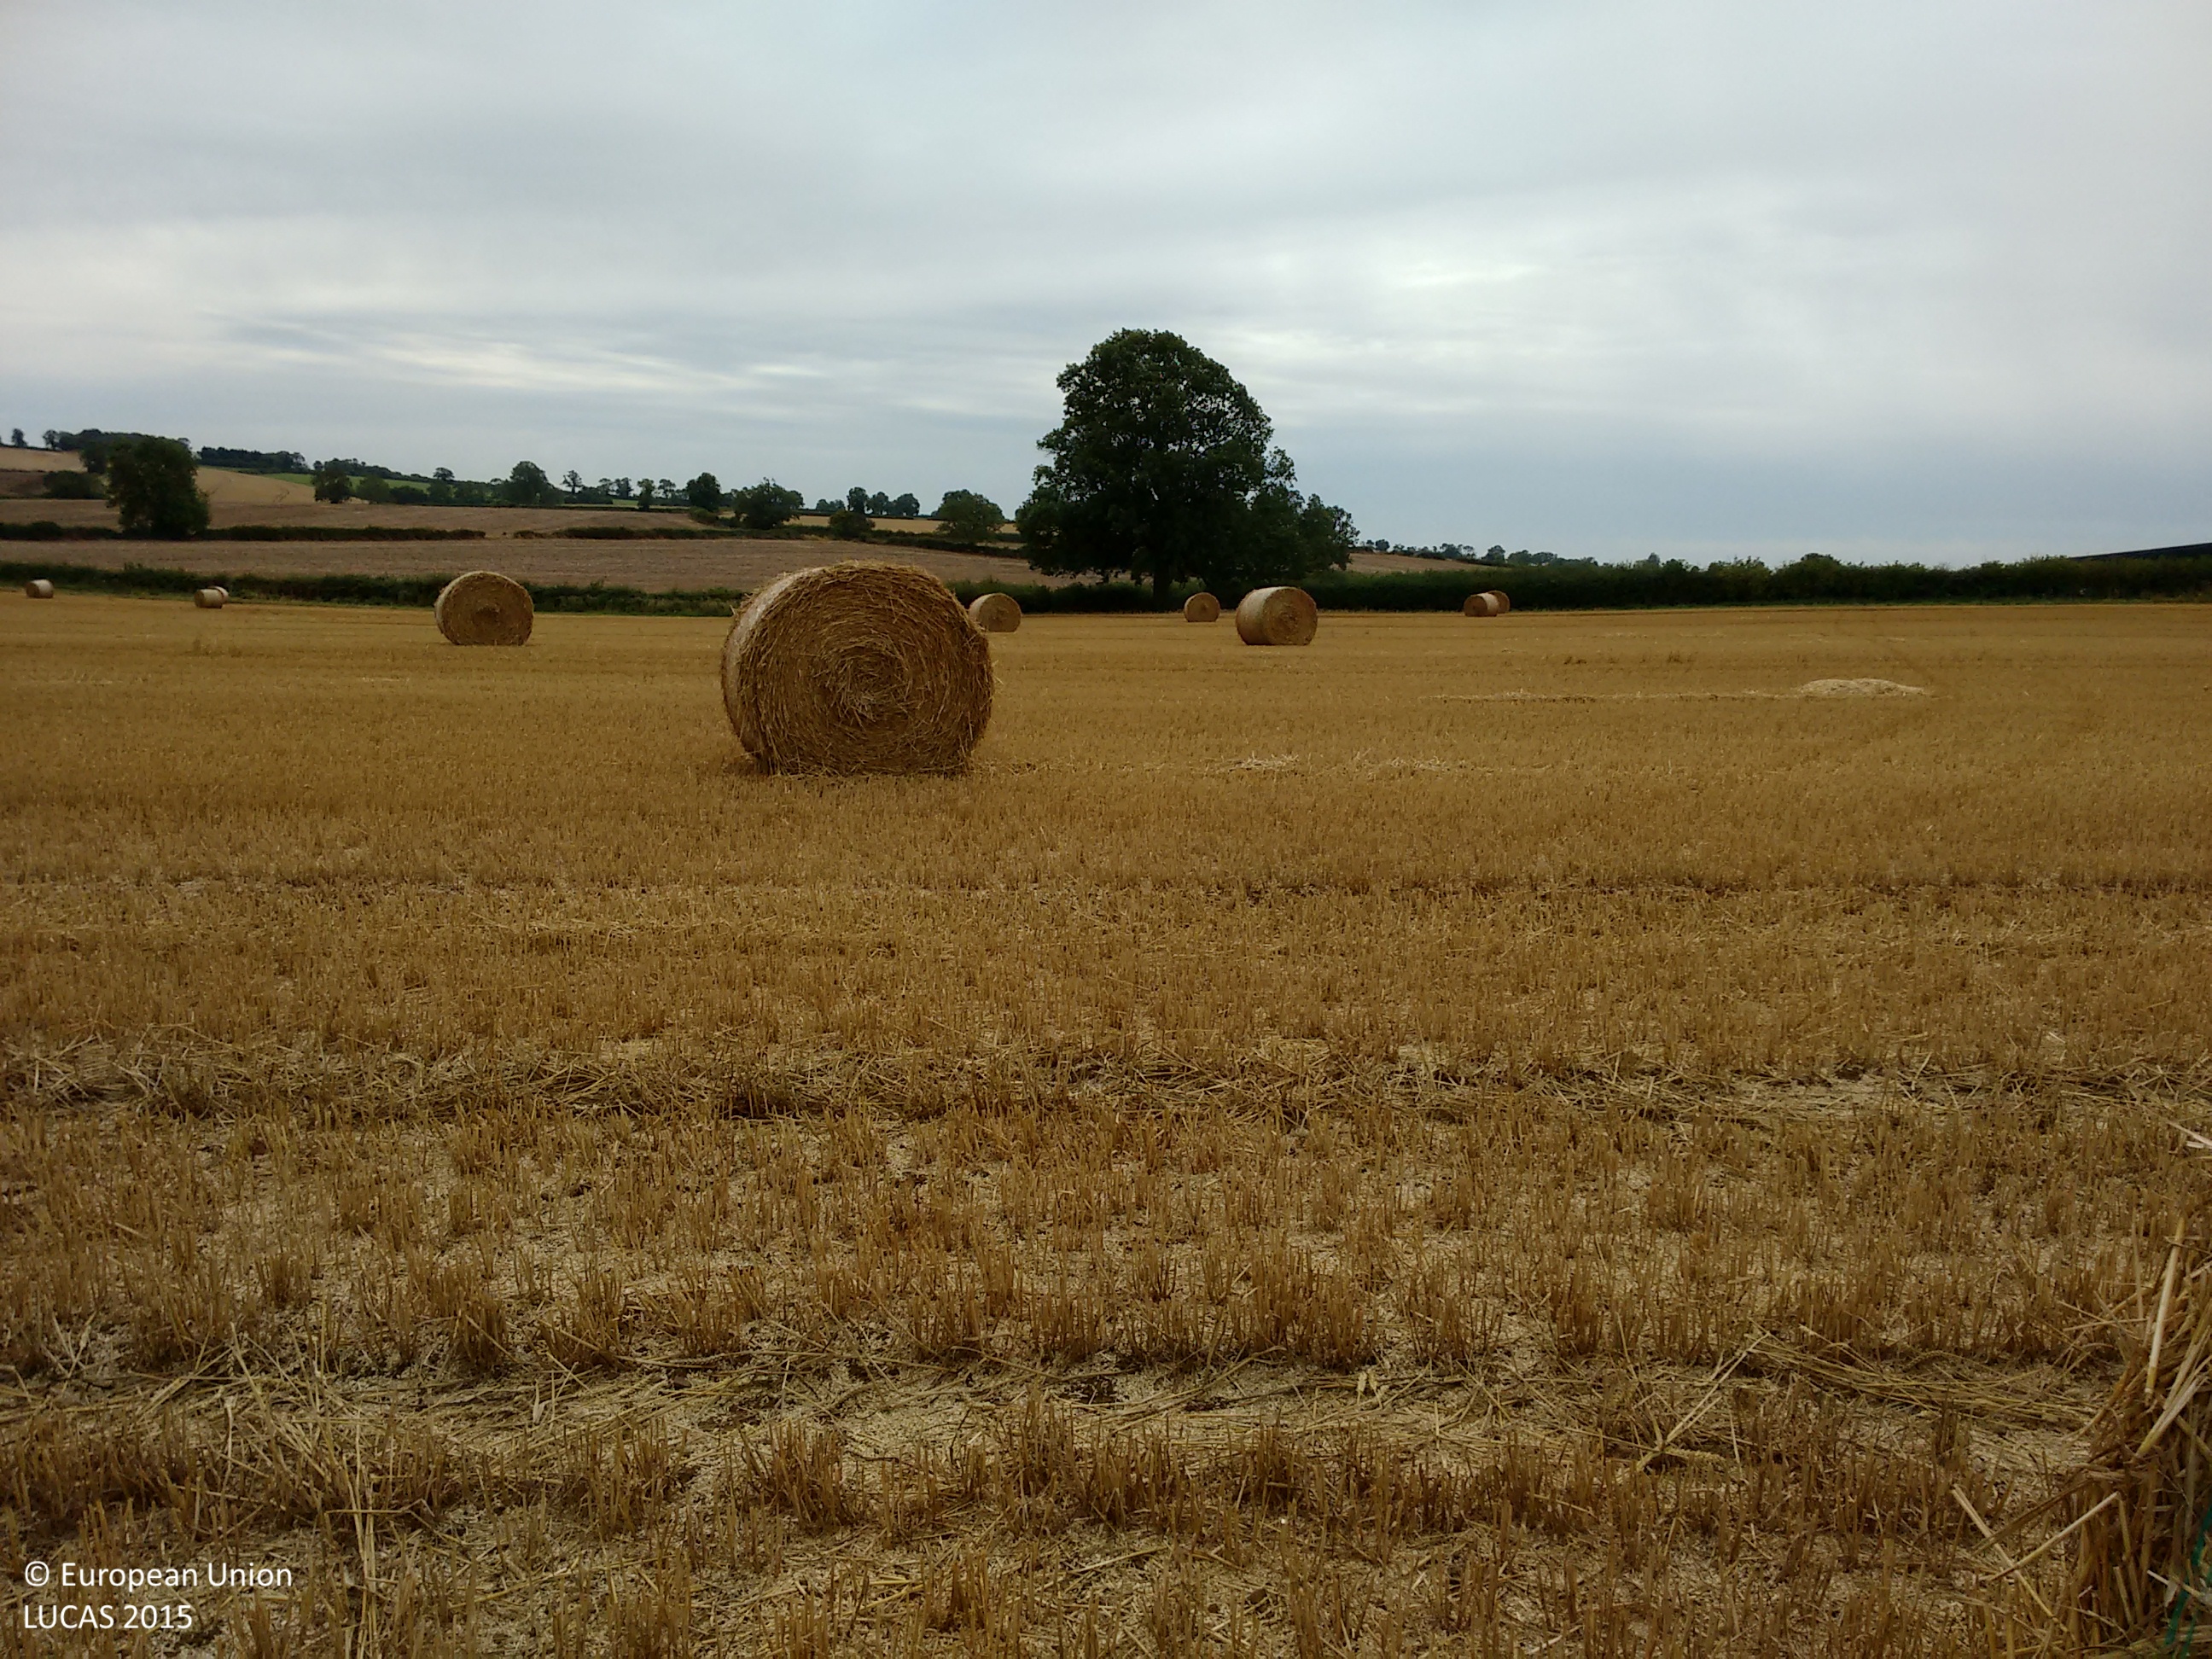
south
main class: Cropland
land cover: Common wheat
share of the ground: 10 - 25 %
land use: Agriculture (excluding fallow land and kitchen gardens)
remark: Harvested field
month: August
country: GB
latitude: 52.4202
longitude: -0.8797
